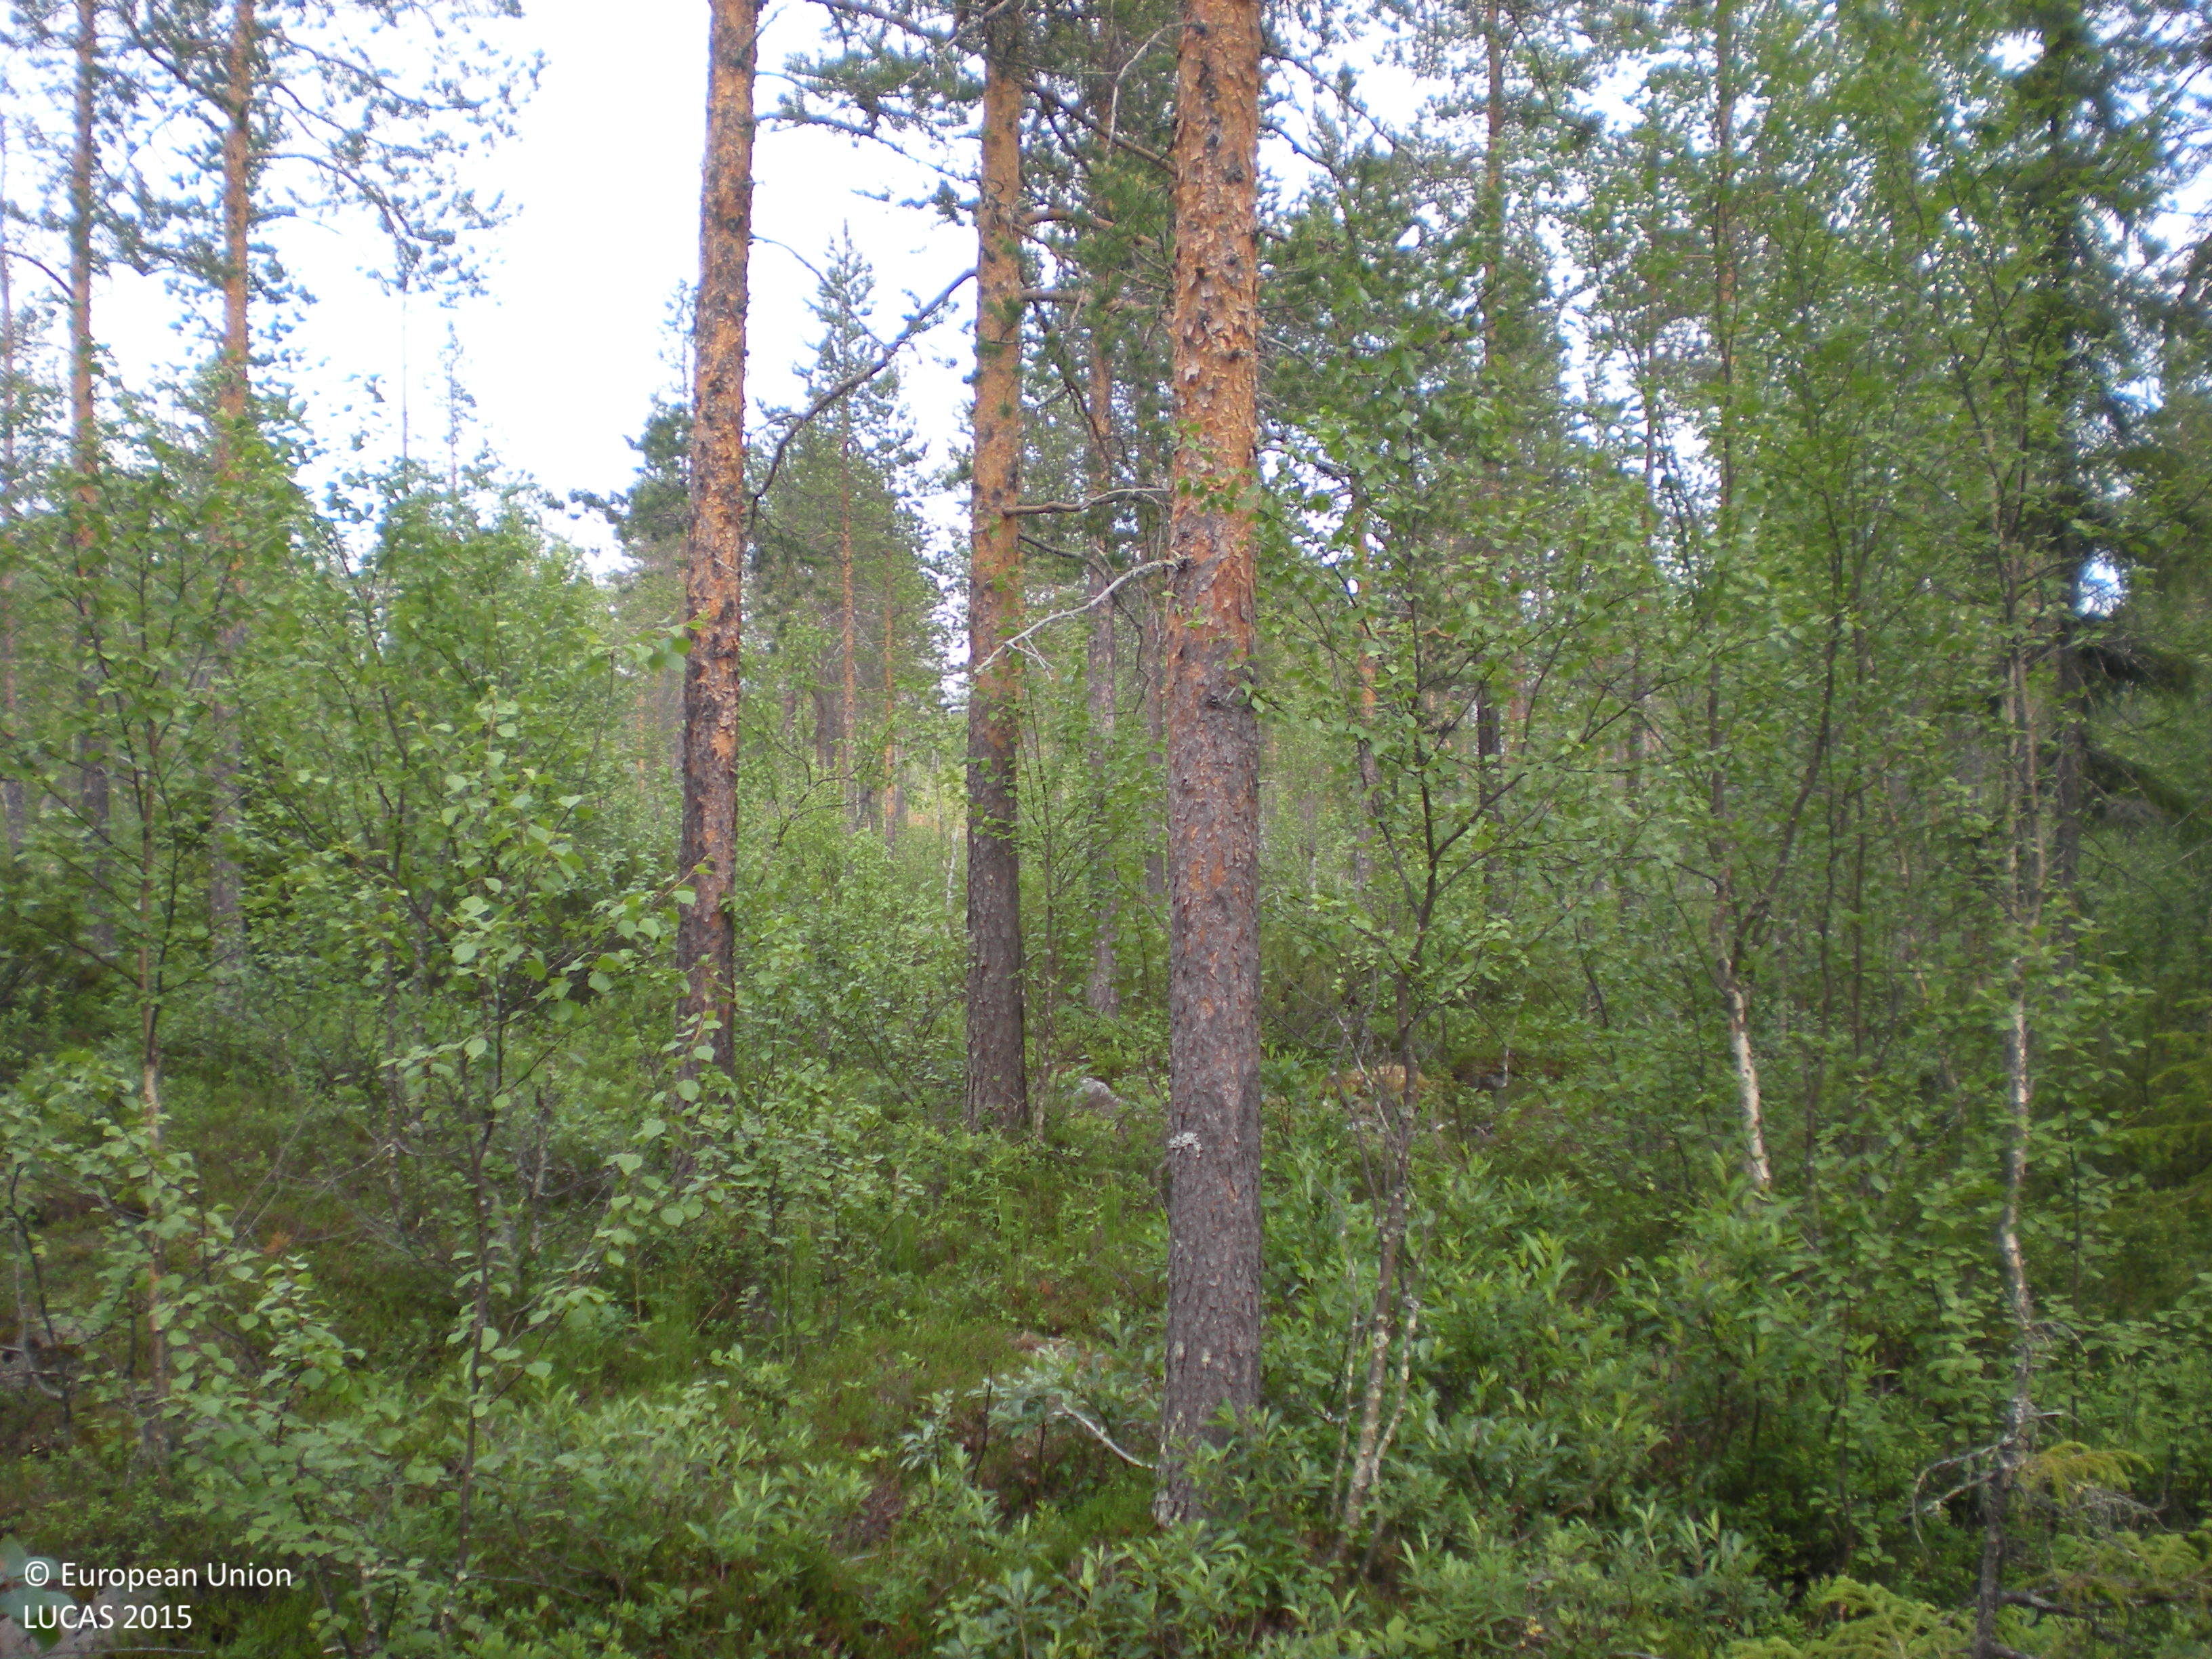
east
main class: Woodland
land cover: Pine dominated mixed woodland
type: boreal forest
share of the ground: 50 - 75 %
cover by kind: coniferous forest trees 40 %, broadleaved forest trees 20 %, shrubs 20 %, lichens and mosses 10 %, herbaceous plants 5 %, consolidated bare surface 5 %
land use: Forestry
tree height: > 5 m
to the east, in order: Pine dominated mixed woodland; Shrubland with sparse tree cover
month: July
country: SE
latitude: 65.4520
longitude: 17.9632
